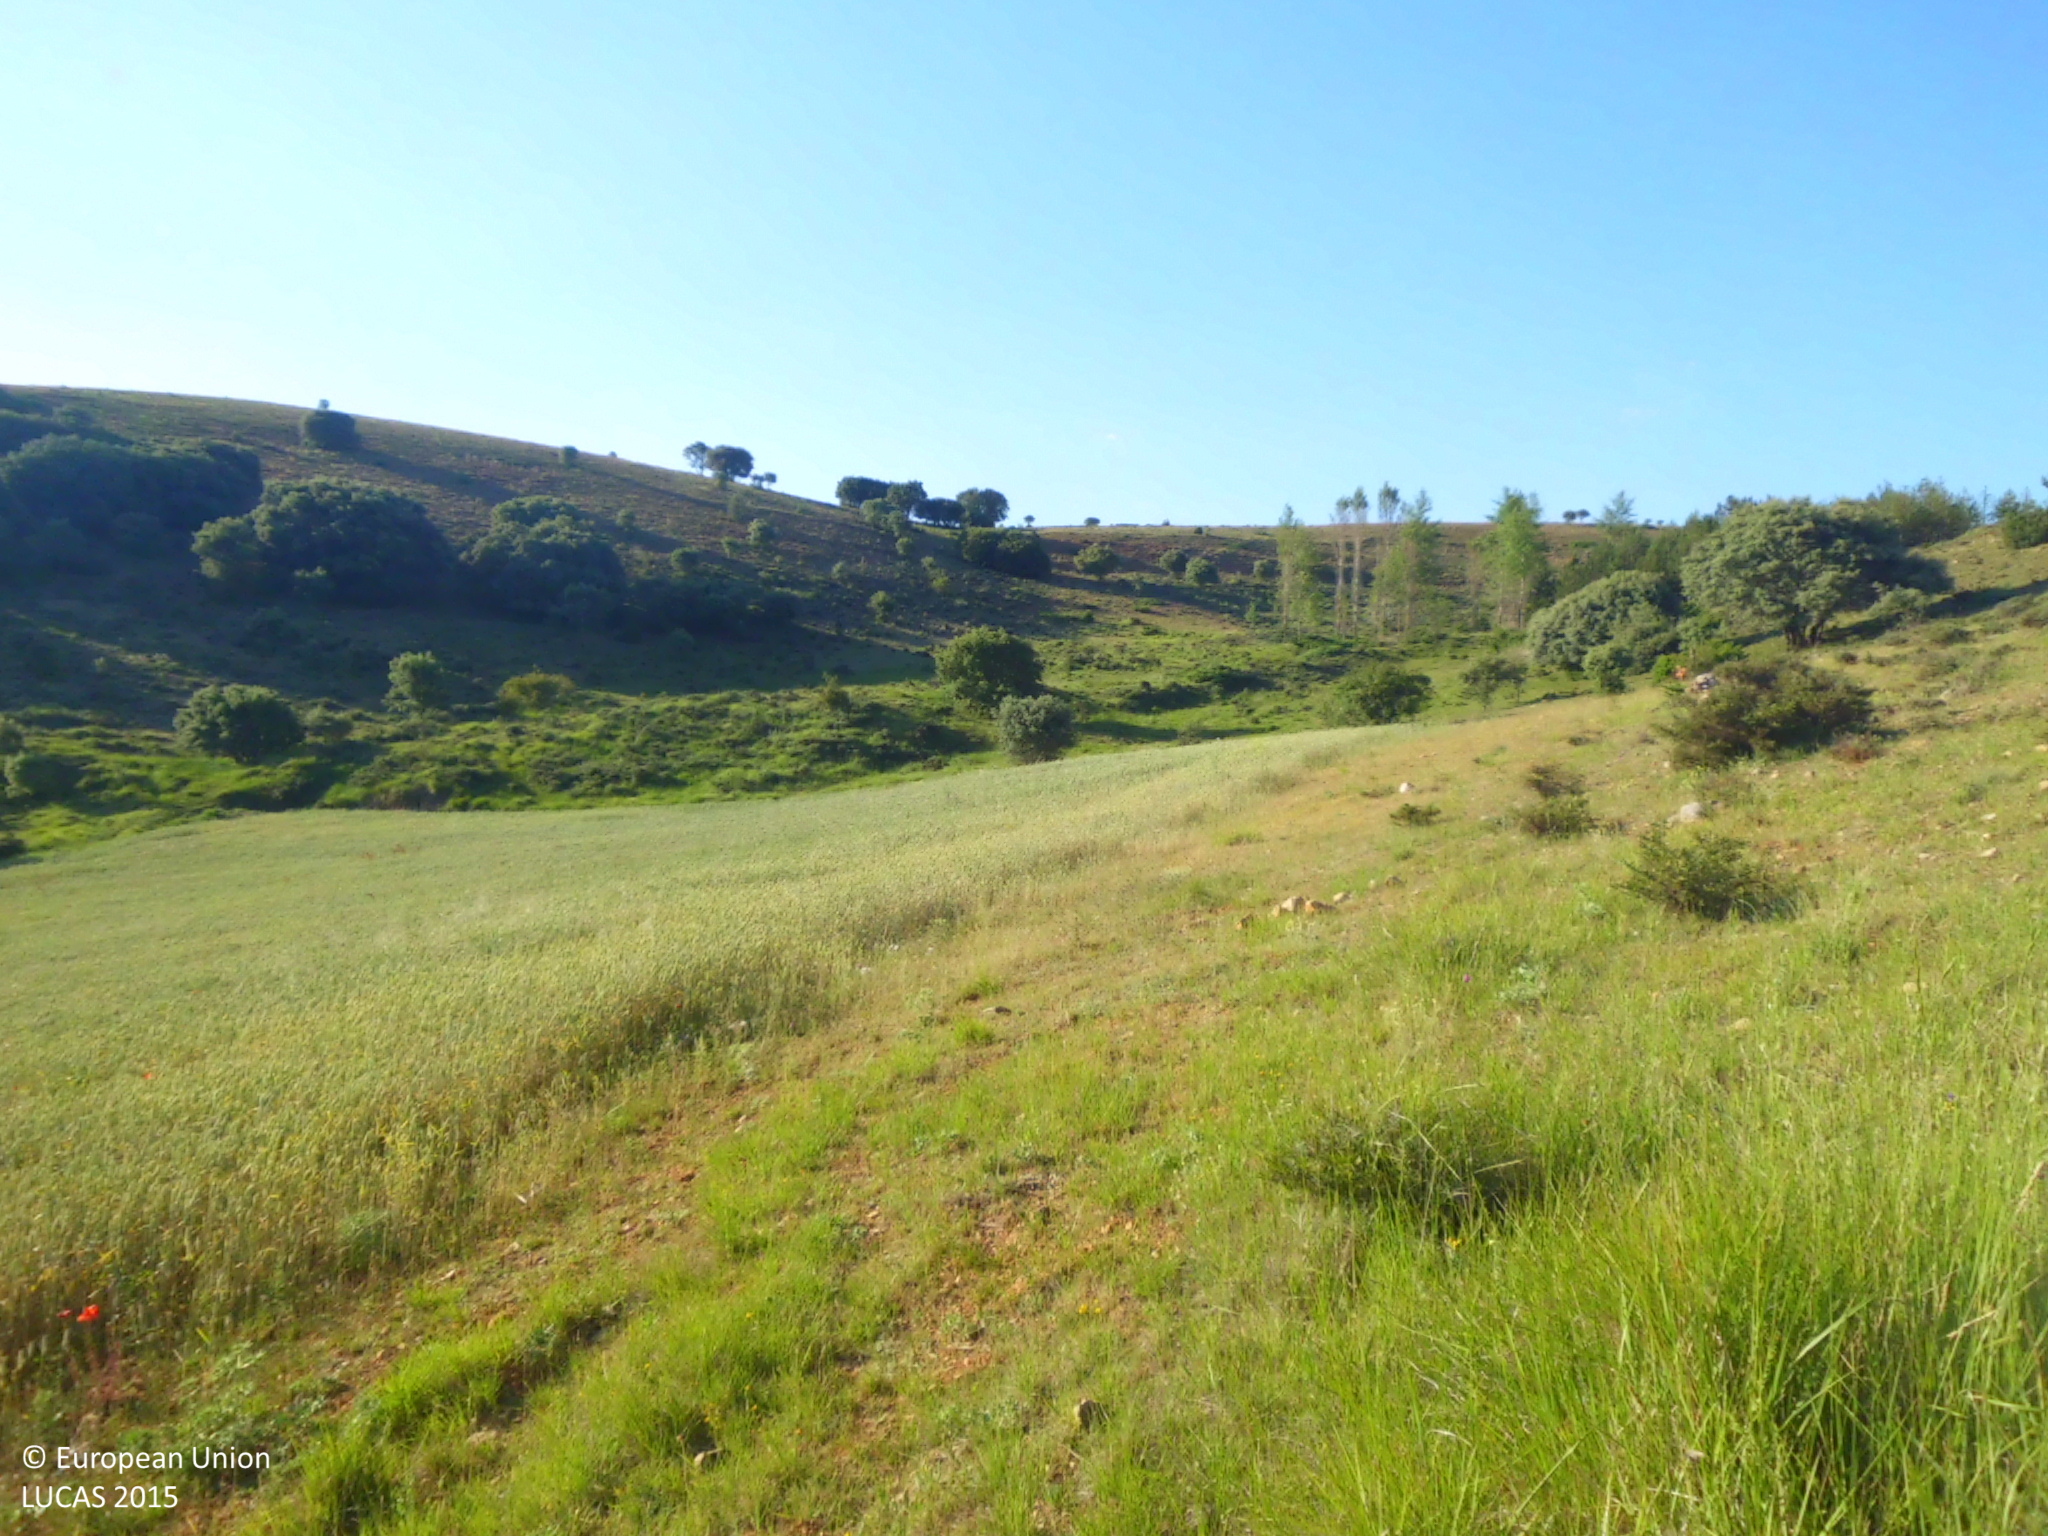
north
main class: Grassland
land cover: Grassland with sparse tree/shrub cover
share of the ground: > 75 %
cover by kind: herbaceous plants 90 %, broadleaved forest trees 5 %, shrubs 5 %
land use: Abandoned areas
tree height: < 5 m
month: June
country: ES
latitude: 42.5773
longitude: -3.9687
